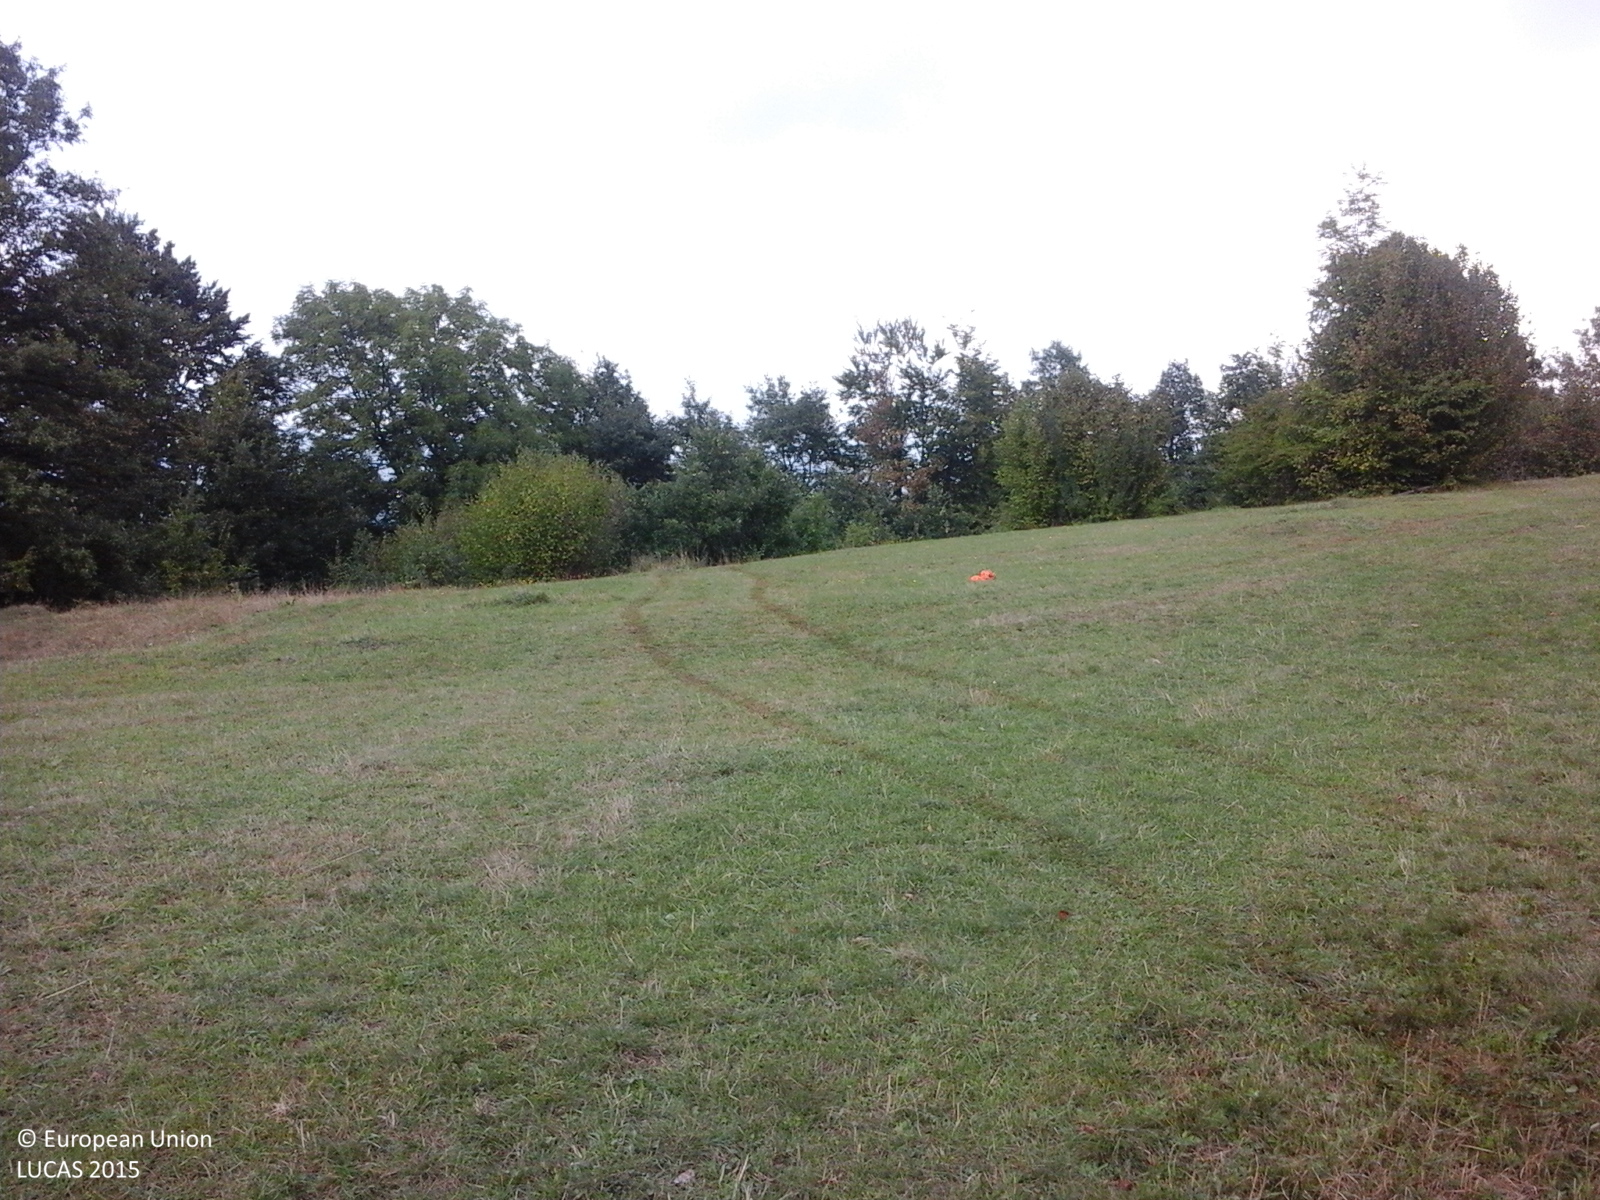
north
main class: Grassland
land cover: Grassland without tree/shrub cover
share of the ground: > 75 %
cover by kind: herbaceous plants 100 %
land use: Agriculture (excluding fallow land and kitchen gardens)
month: September
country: RO
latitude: 46.9235
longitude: 22.6769
